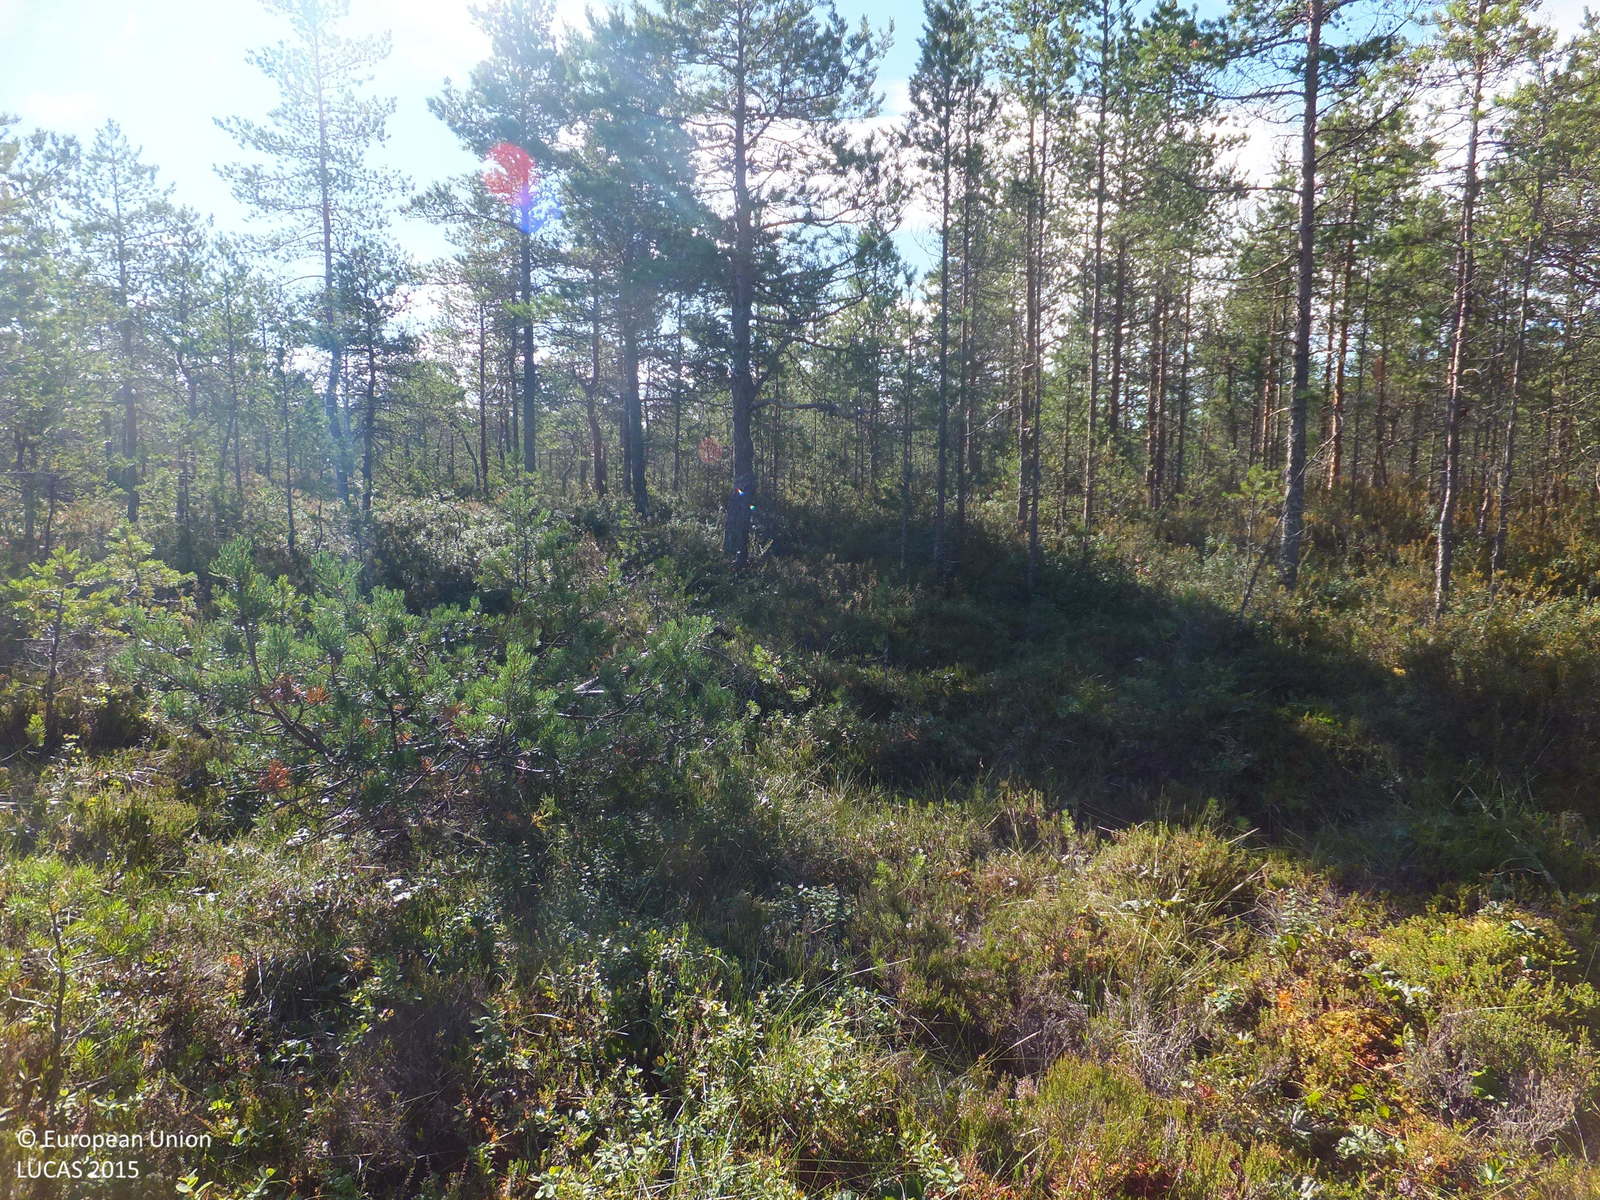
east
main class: Woodland
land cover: Pine dominated coniferous woodland
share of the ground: 50 - 75 %
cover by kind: coniferous forest trees 50 %, shrubs 30 %, lichens and mosses 15 %, herbaceous plants 5 %
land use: Forestry
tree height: < 5 m
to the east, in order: Pine dominated coniferous woodland; Ditches and canals; Pine dominated coniferous woodland; Ditches and canals; Pine dominated coniferous woodland
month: August
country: FI
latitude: 63.1044
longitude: 22.8357
